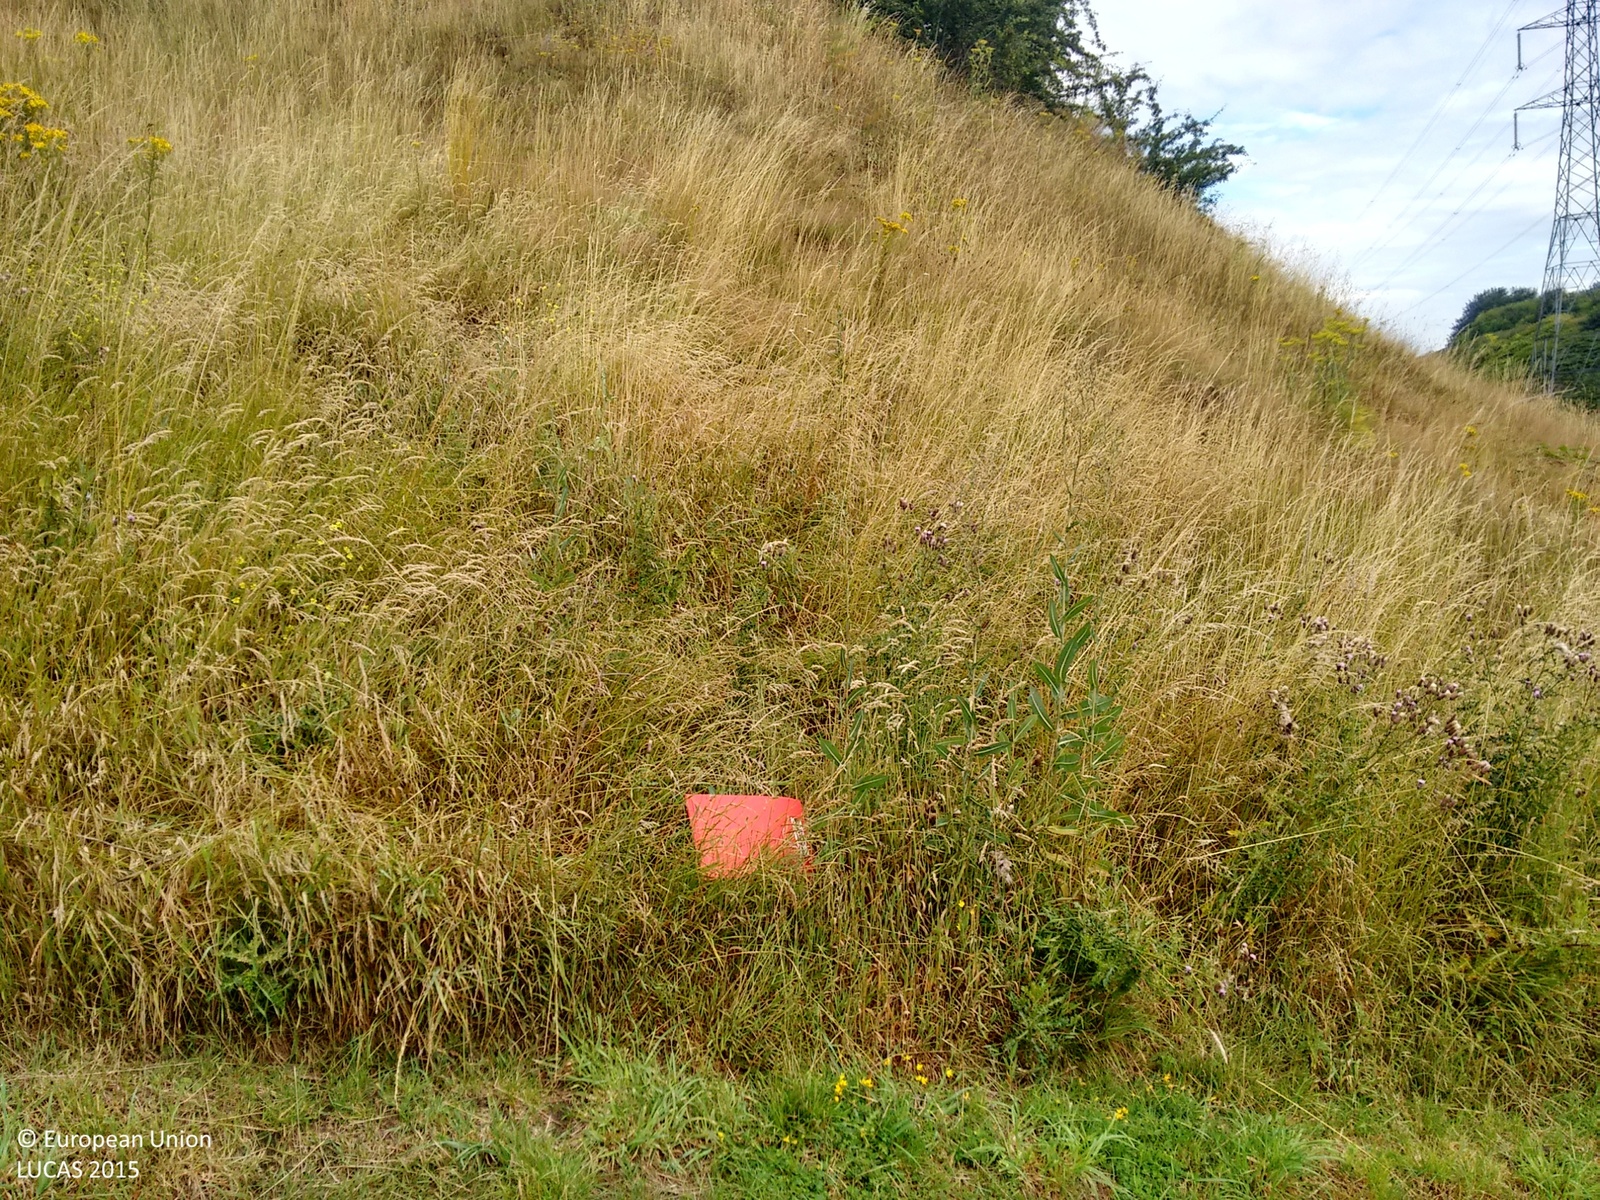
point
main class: Grassland
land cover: Grassland without tree/shrub cover
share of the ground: > 75 %
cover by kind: herbaceous plants 100 %
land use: Water transport
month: July
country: GB
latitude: 52.5491
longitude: -1.9886
